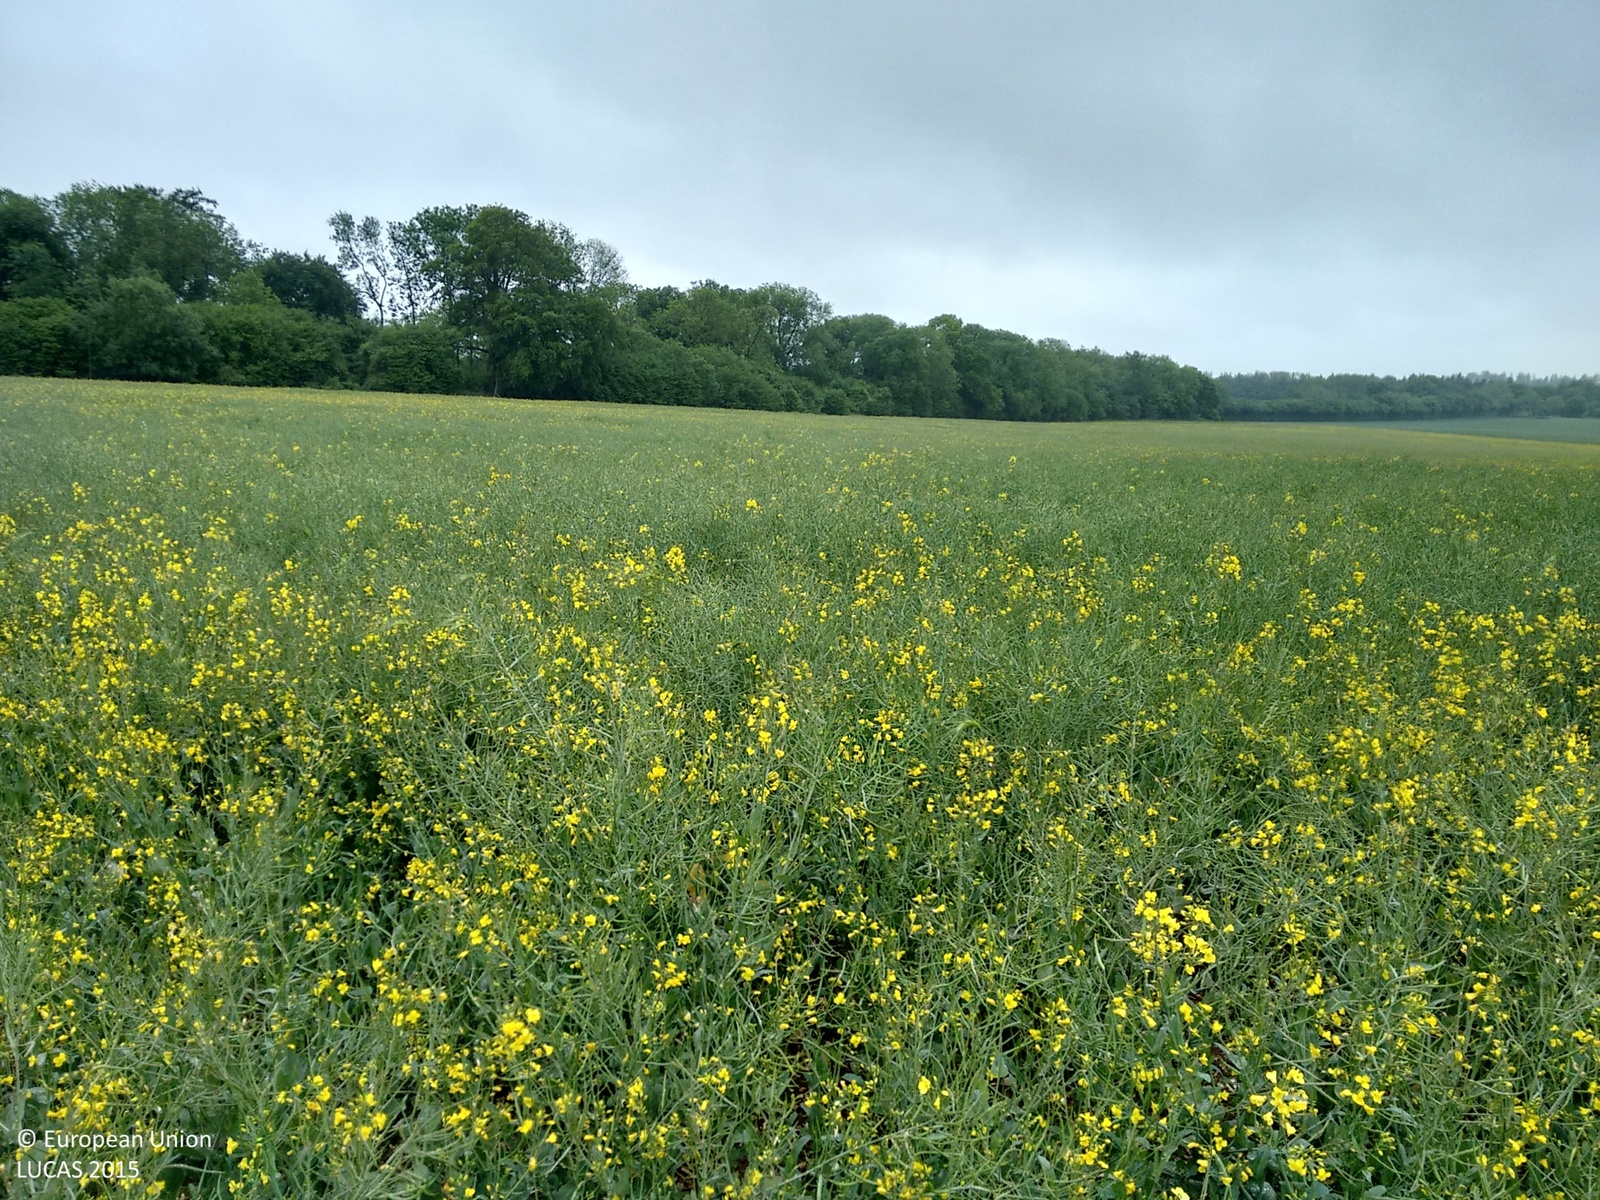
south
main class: Cropland
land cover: Rape and turnip rape
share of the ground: > 75 %
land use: Agriculture (excluding fallow land and kitchen gardens)
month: June
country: GB
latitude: 51.1271
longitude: -1.1199
